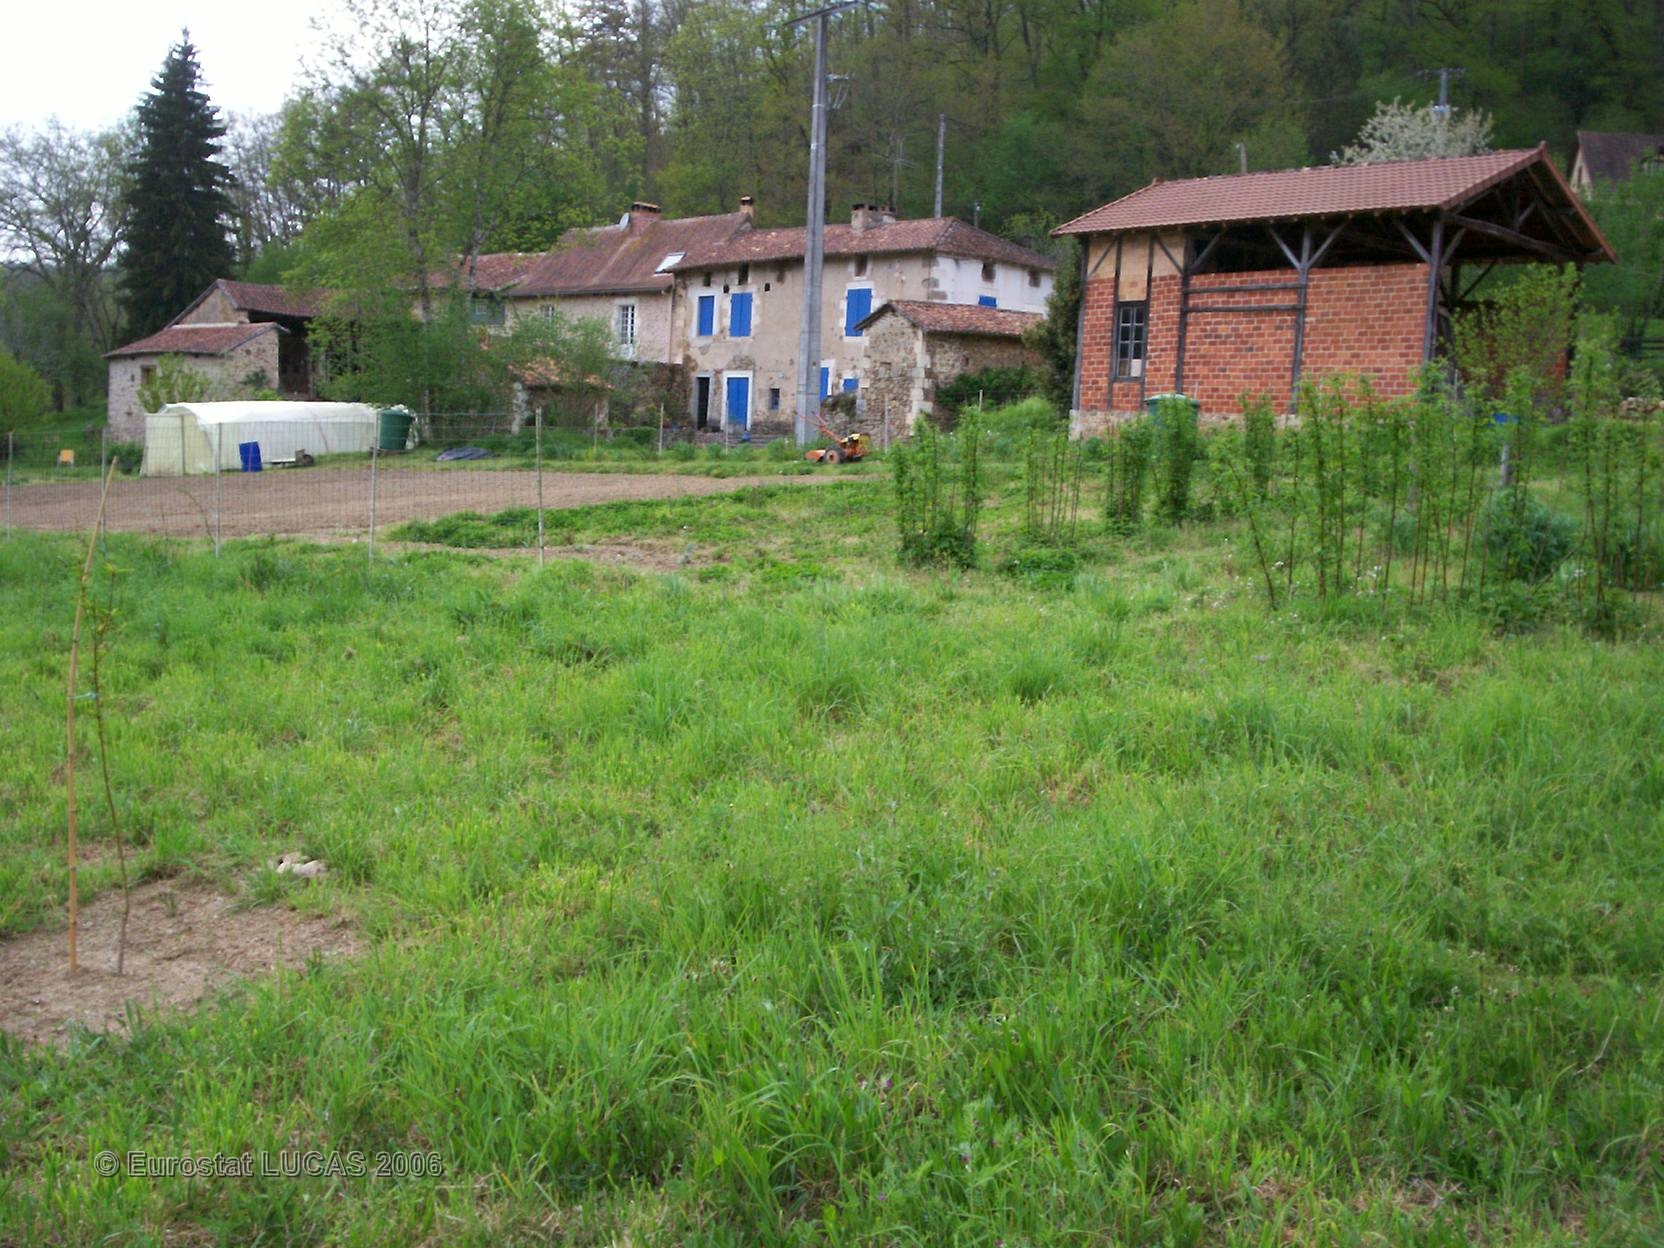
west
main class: Grassland
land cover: Grassland without tree/shrub cover
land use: Residential
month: April
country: FR
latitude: 45.5154
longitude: 0.7592
